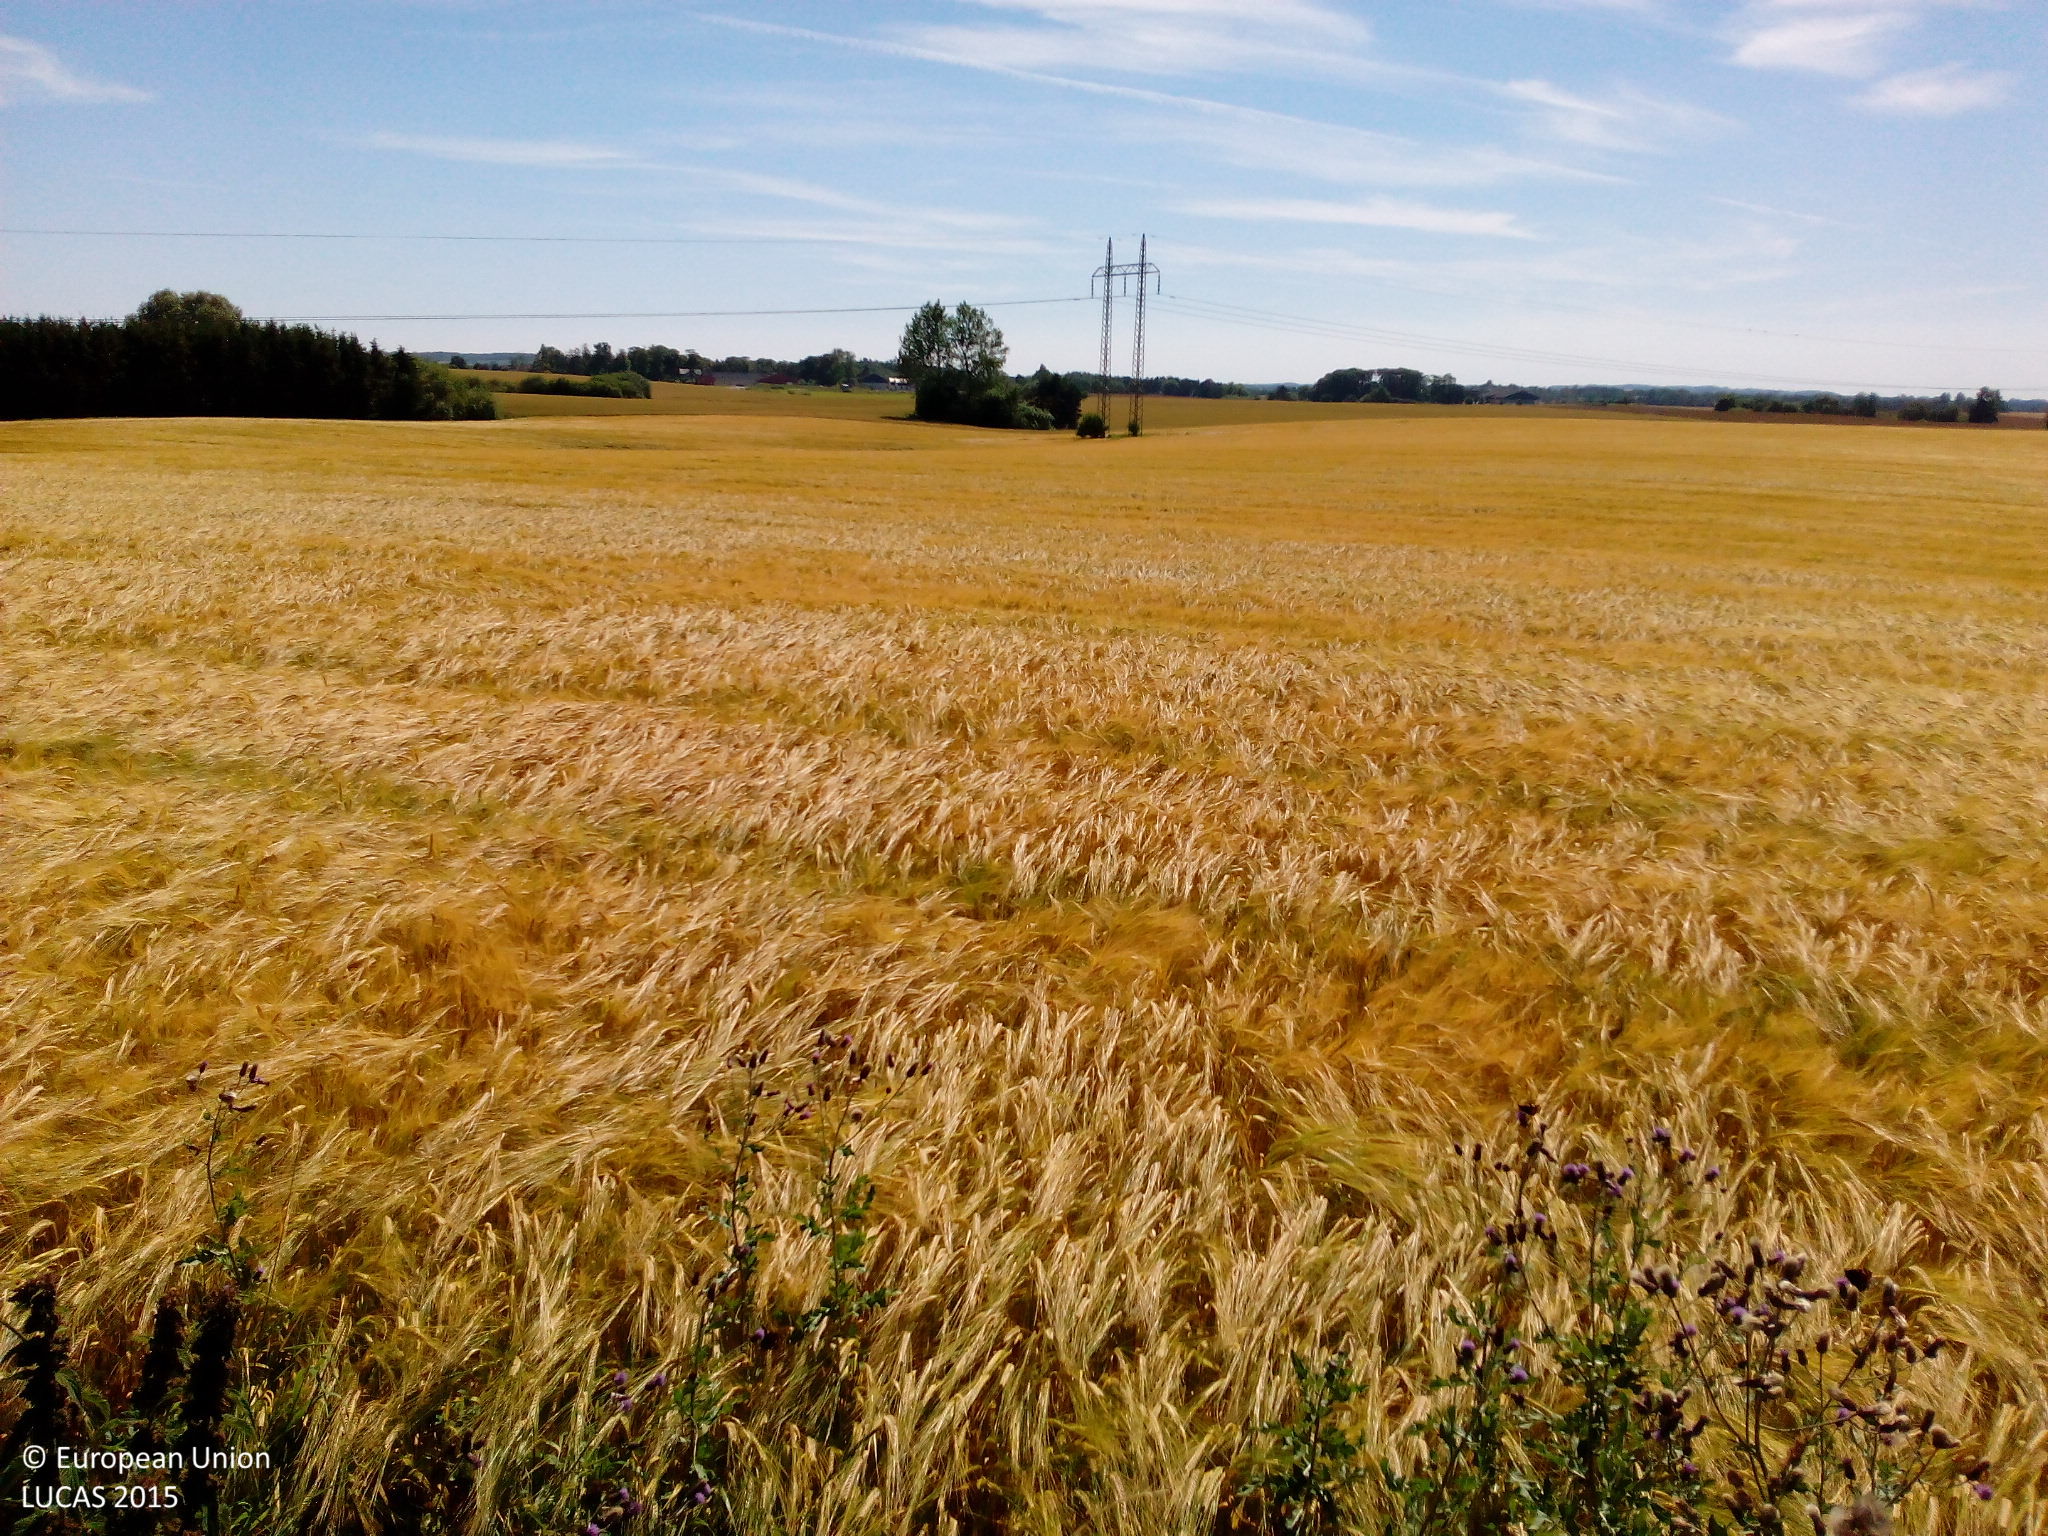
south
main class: Cropland
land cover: Rape and turnip rape
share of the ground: > 75 %
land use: Agriculture (excluding fallow land and kitchen gardens)
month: August
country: DK
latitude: 55.5999
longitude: 11.7918
